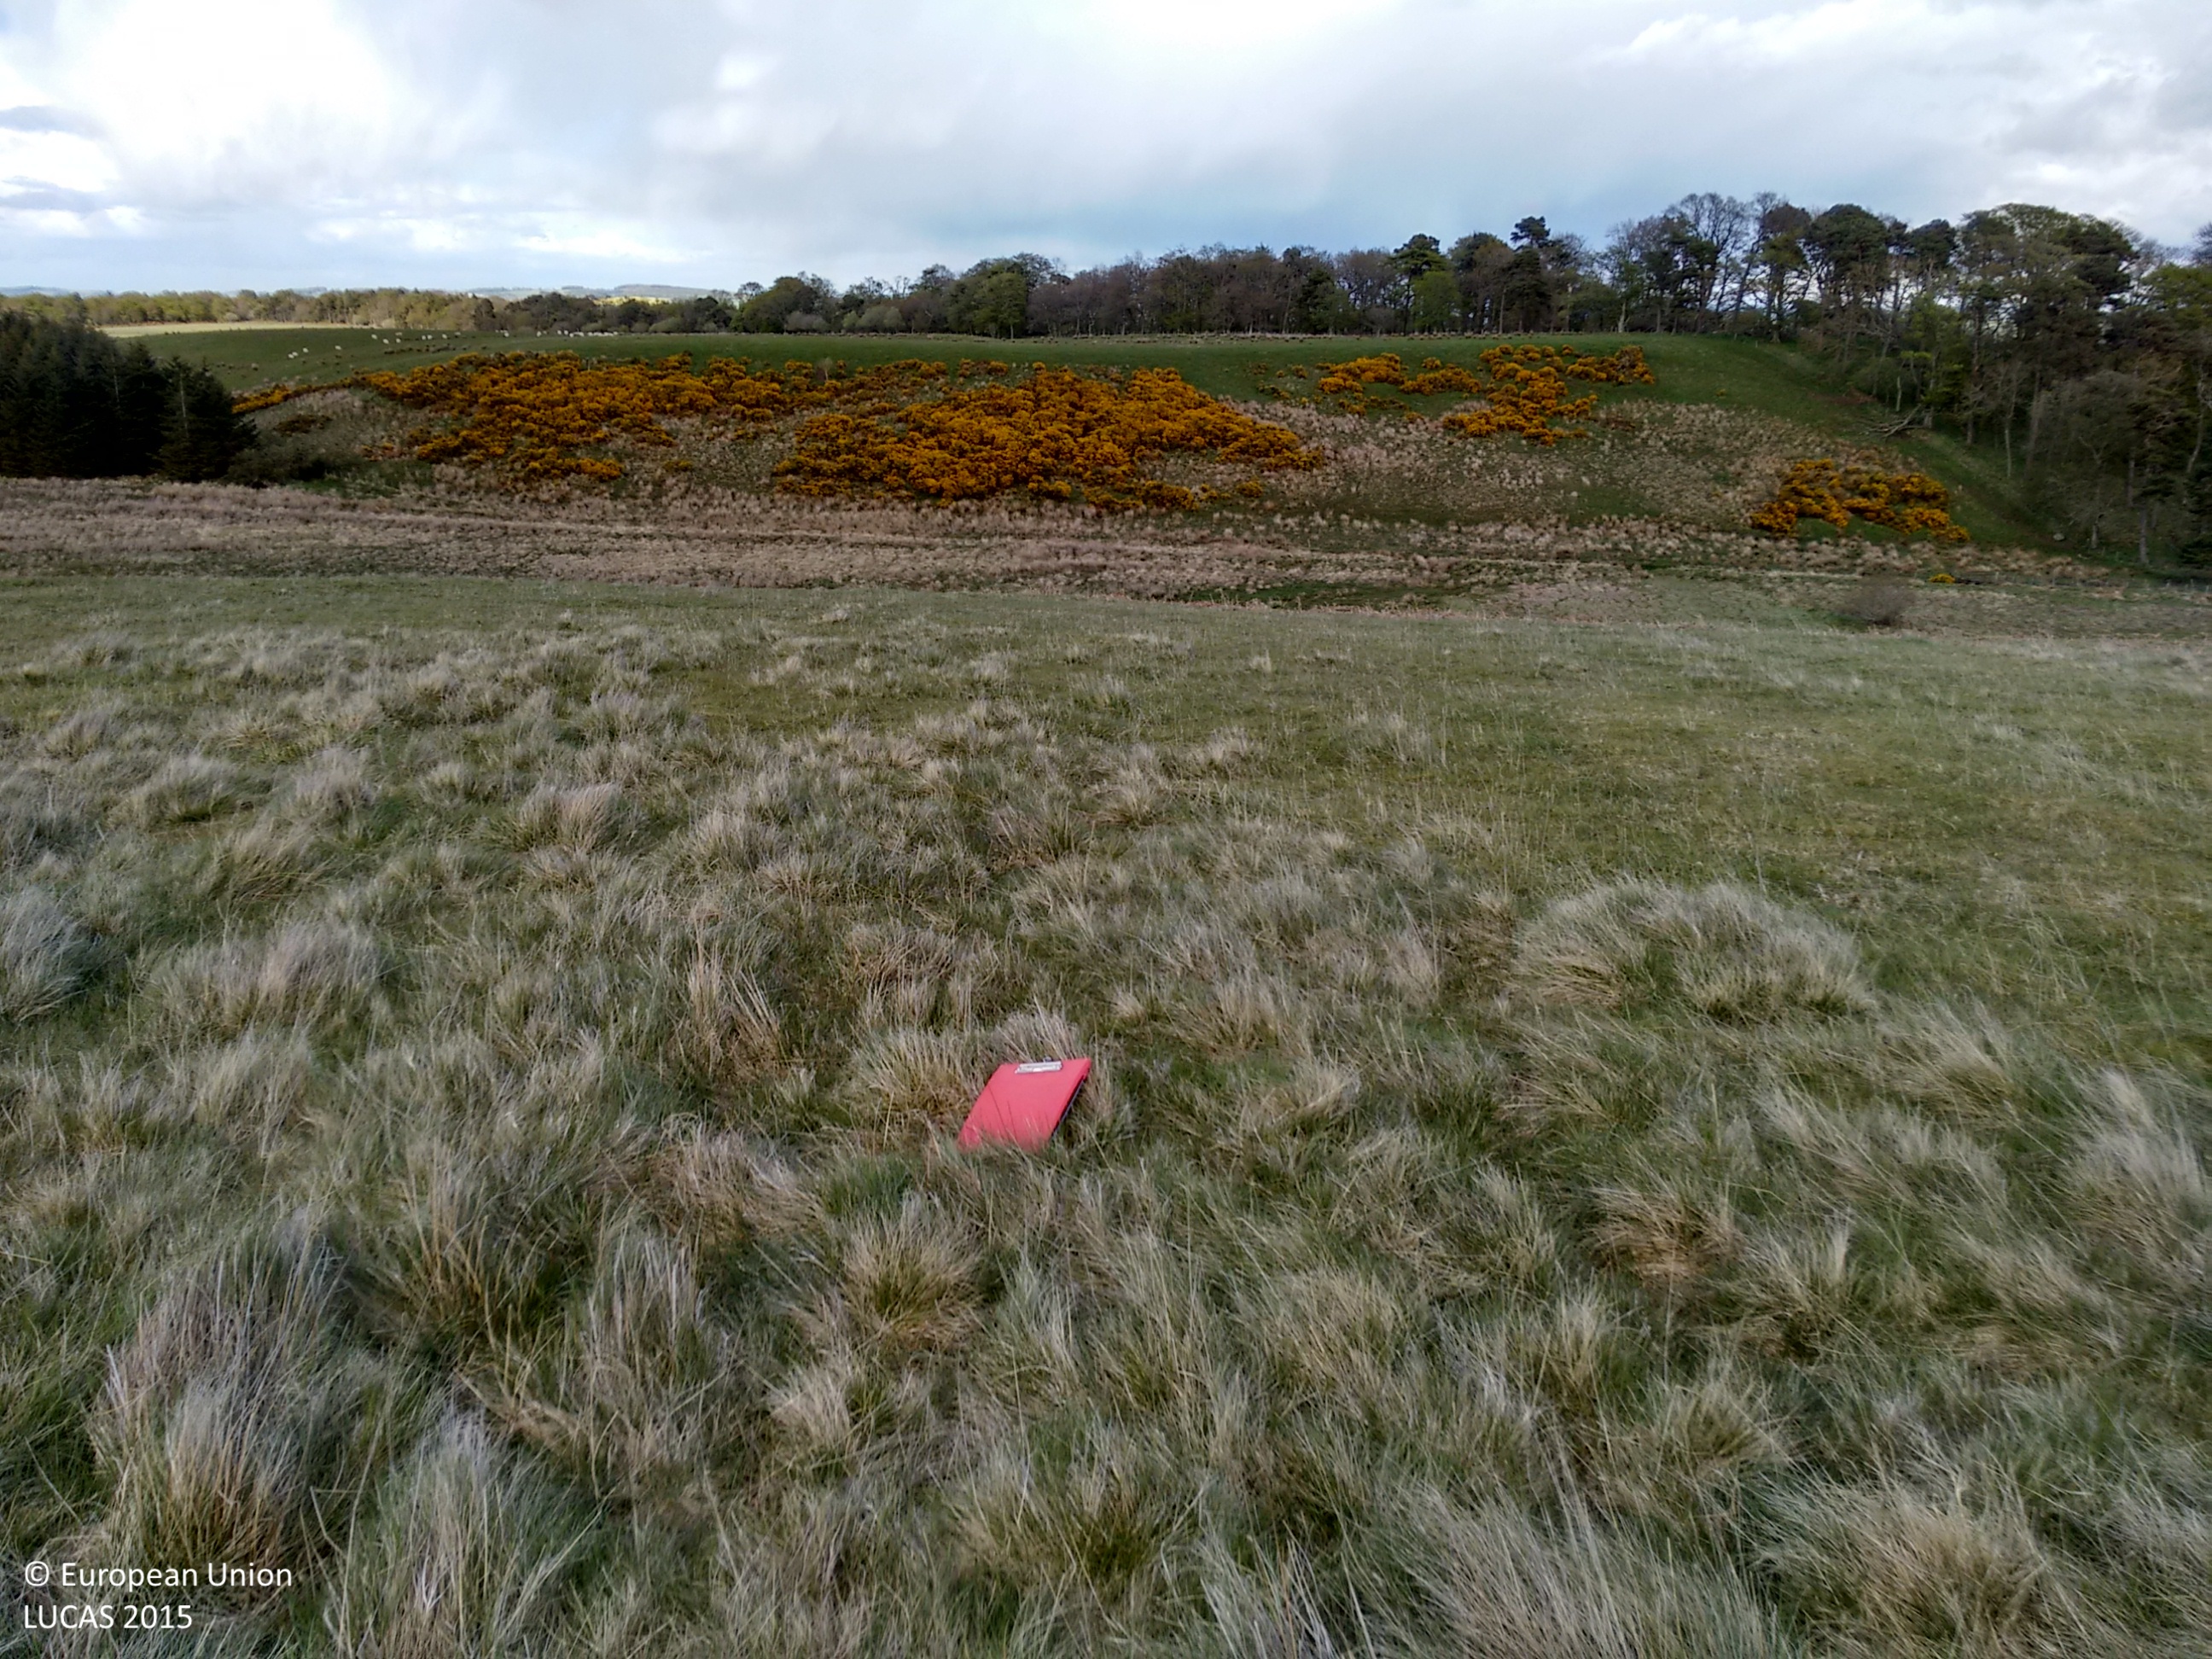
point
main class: Grassland
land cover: Grassland without tree/shrub cover
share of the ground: > 75 %
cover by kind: herbaceous plants 100 %
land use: Agriculture (excluding fallow land and kitchen gardens)
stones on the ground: < 10 %
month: May
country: GB
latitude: 55.8181
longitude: -3.1422
